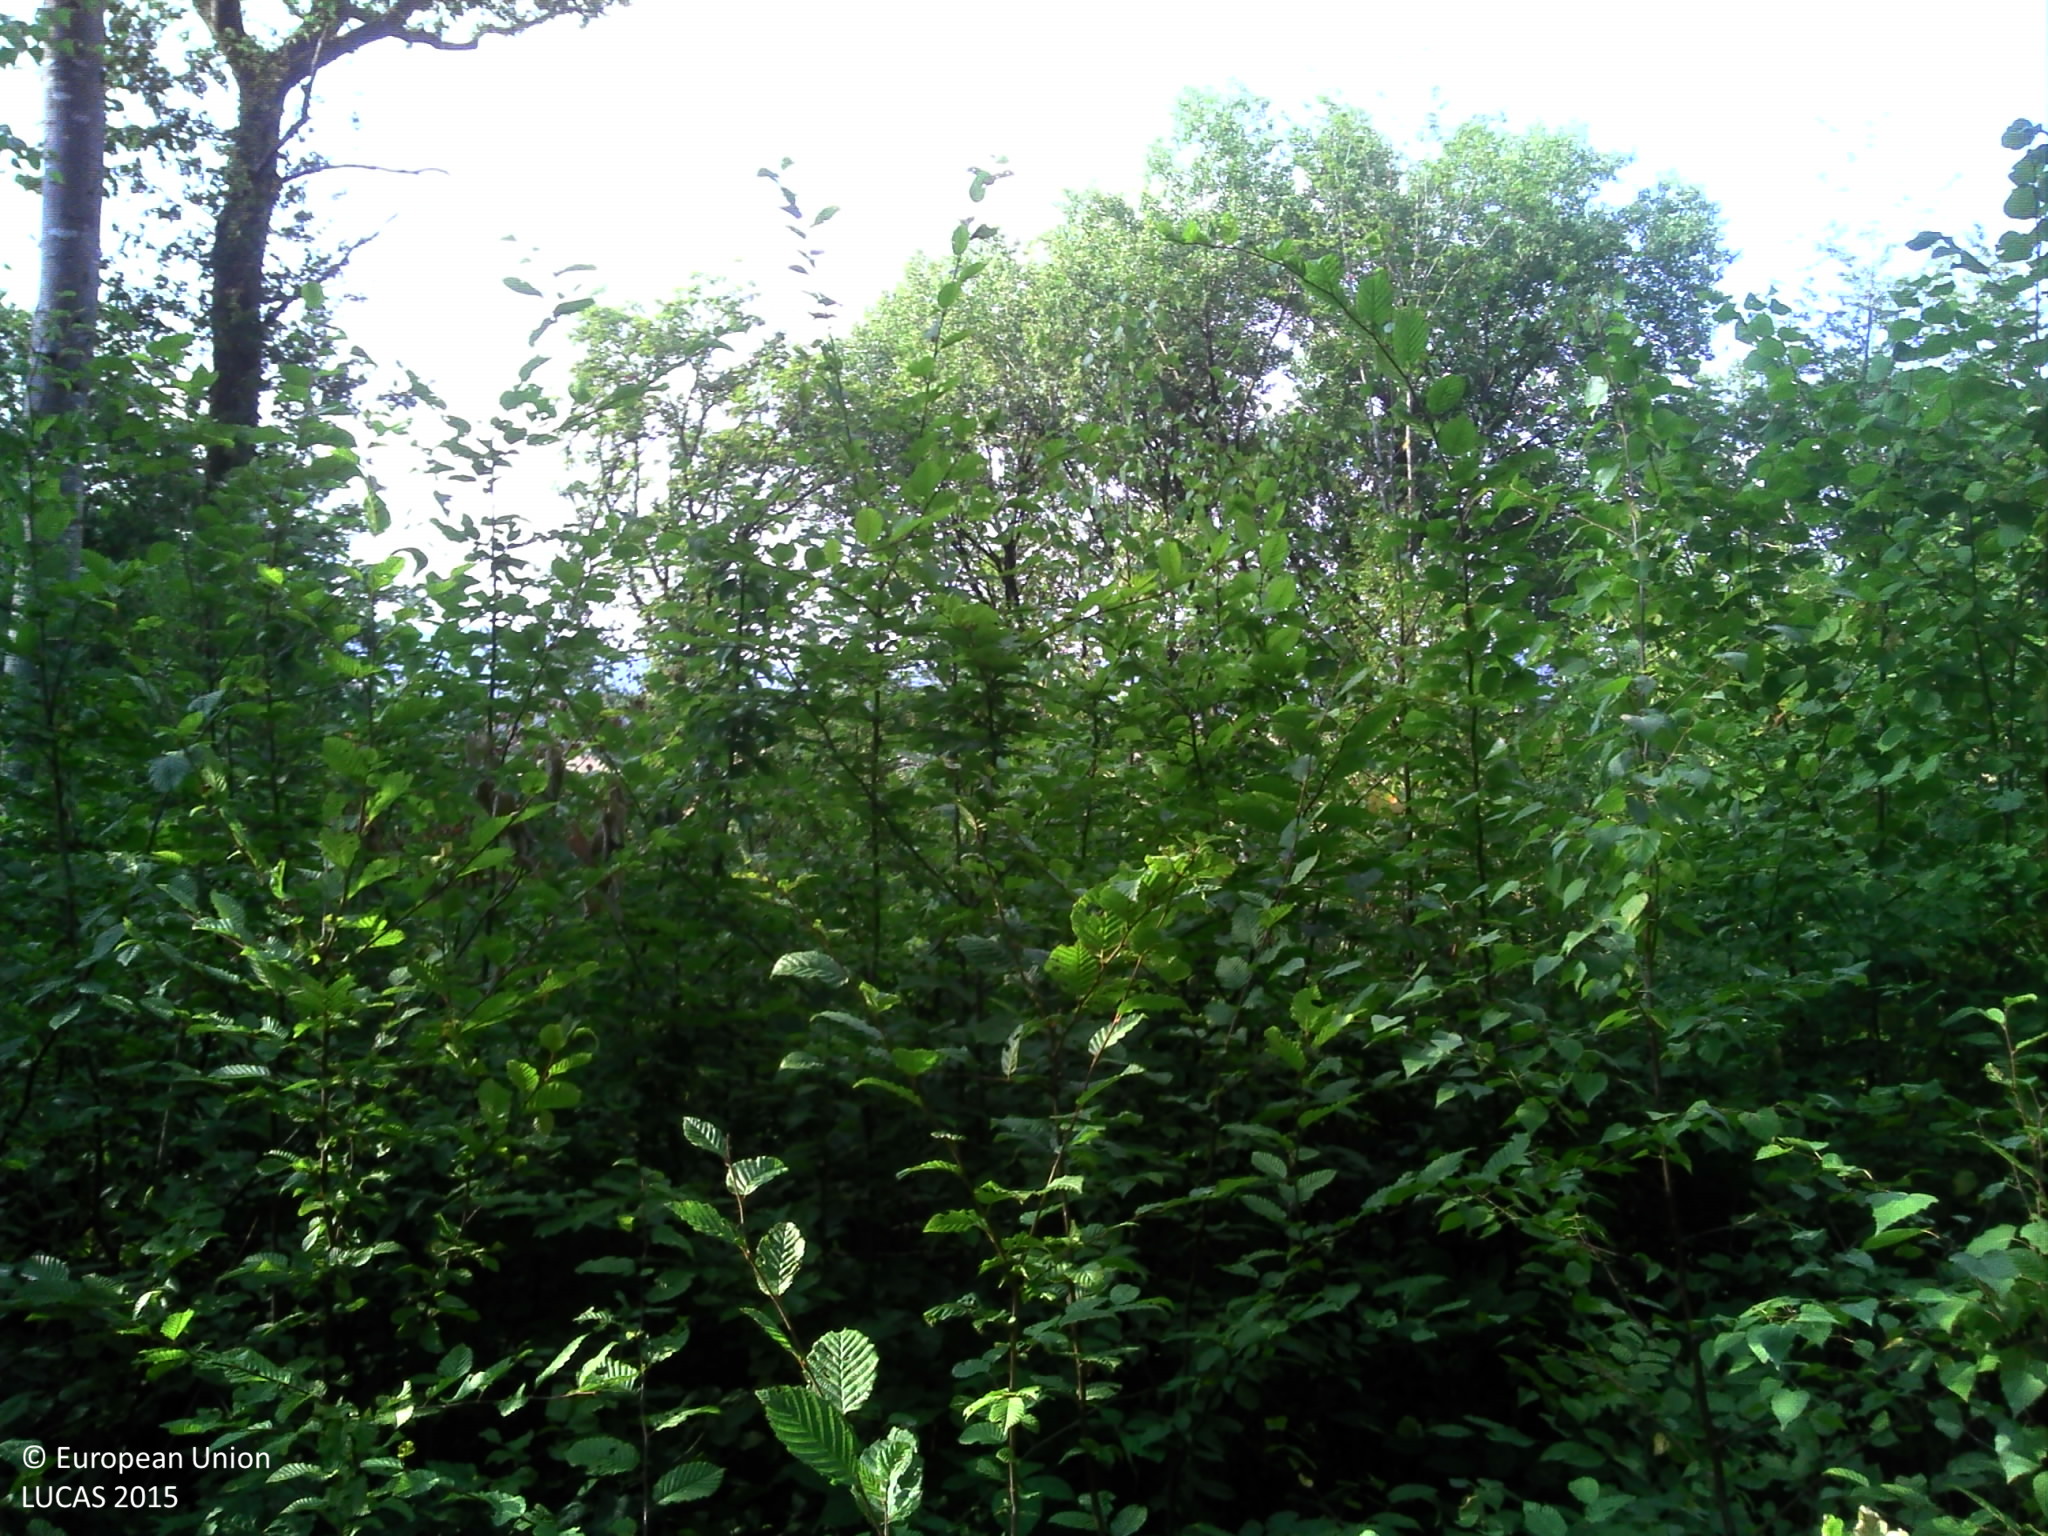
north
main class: Woodland
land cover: Broadleaved woodland
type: mesophytic deciduous forest
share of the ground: > 75 %
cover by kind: broadleaved forest trees 80 %, herbaceous plants 15 %, lichens and mosses 5 %
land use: Semi-natural and natural areas not in use
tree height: > 5 m
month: August
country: FR
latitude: 47.0324
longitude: 4.3545
